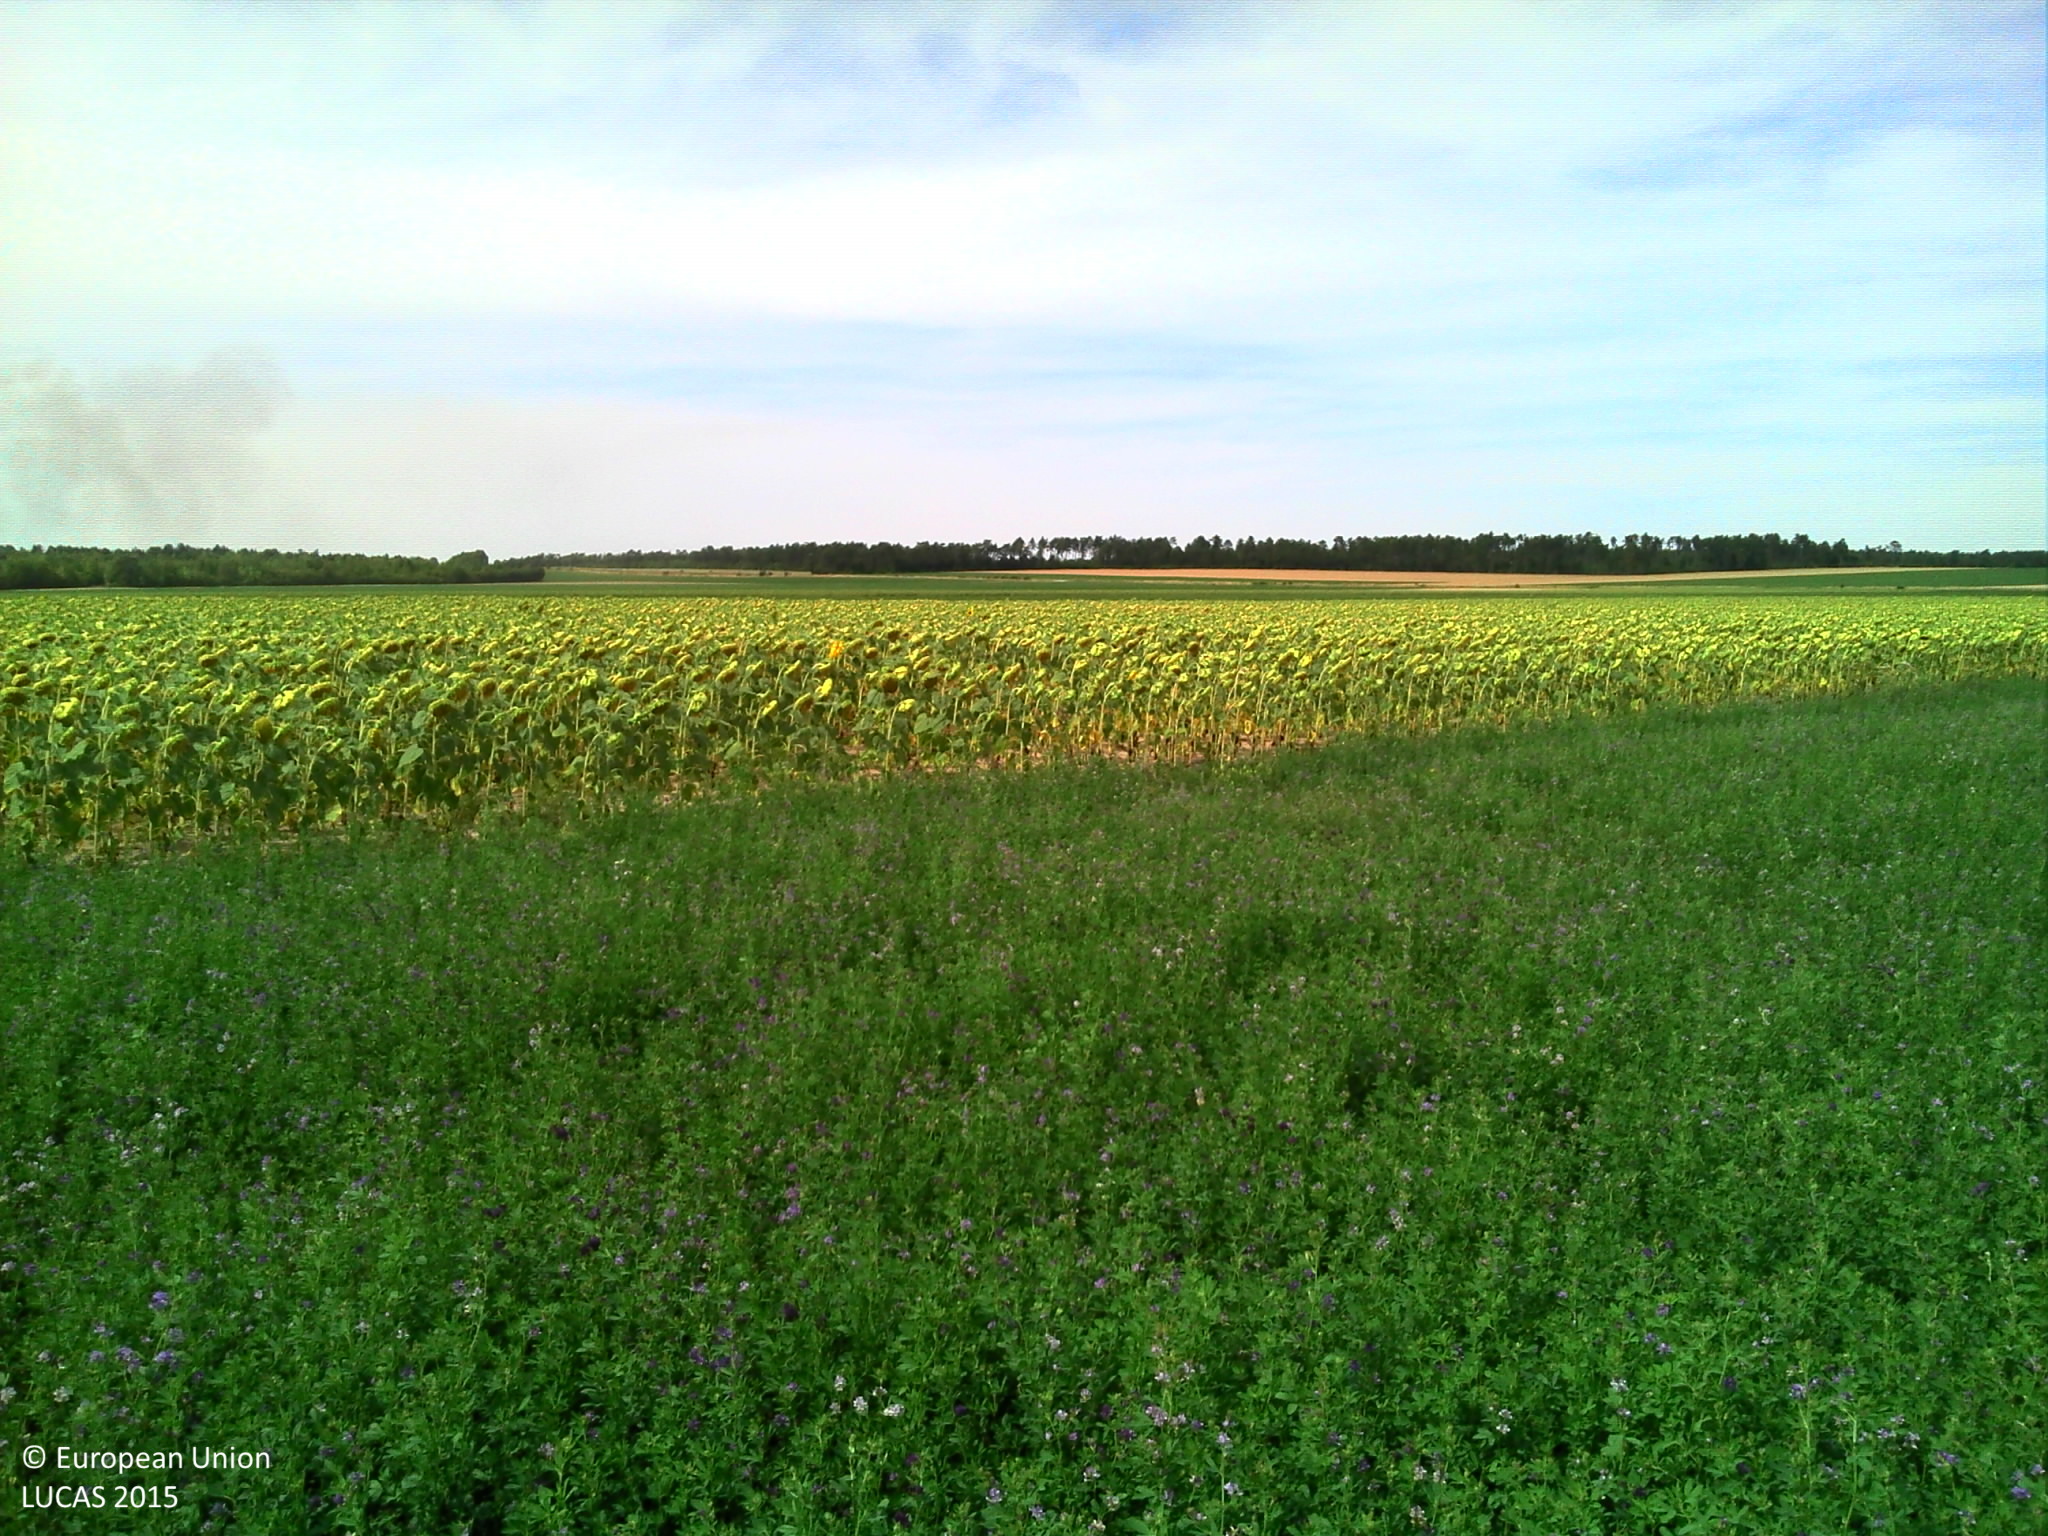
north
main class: Cropland
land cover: Lucerne
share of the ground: > 75 %
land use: Agriculture (excluding fallow land and kitchen gardens)
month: August
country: FR
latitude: 49.1406
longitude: 4.3073
